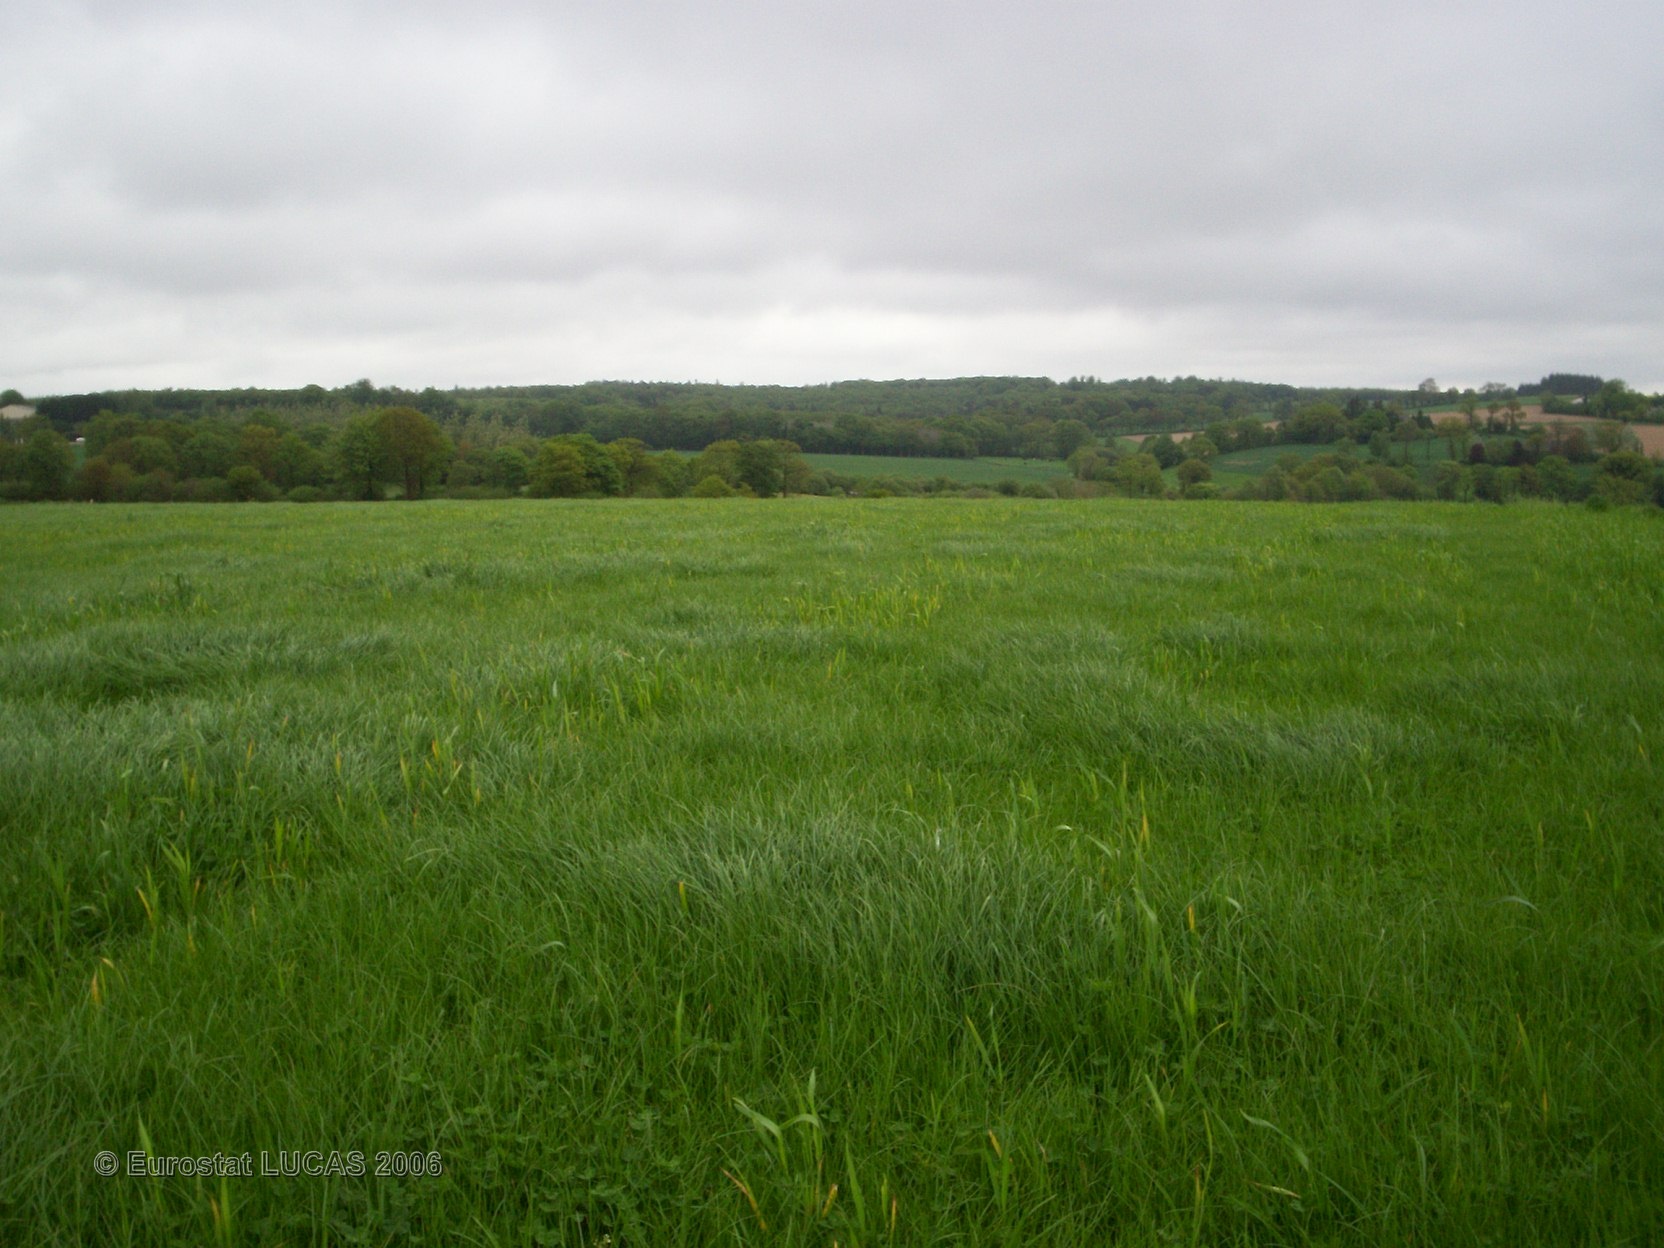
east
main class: Grassland
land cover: Grassland without tree/shrub cover
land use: Agriculture (excluding fallow land and kitchen gardens)
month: May
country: FR
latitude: 48.2899
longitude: -2.8300
